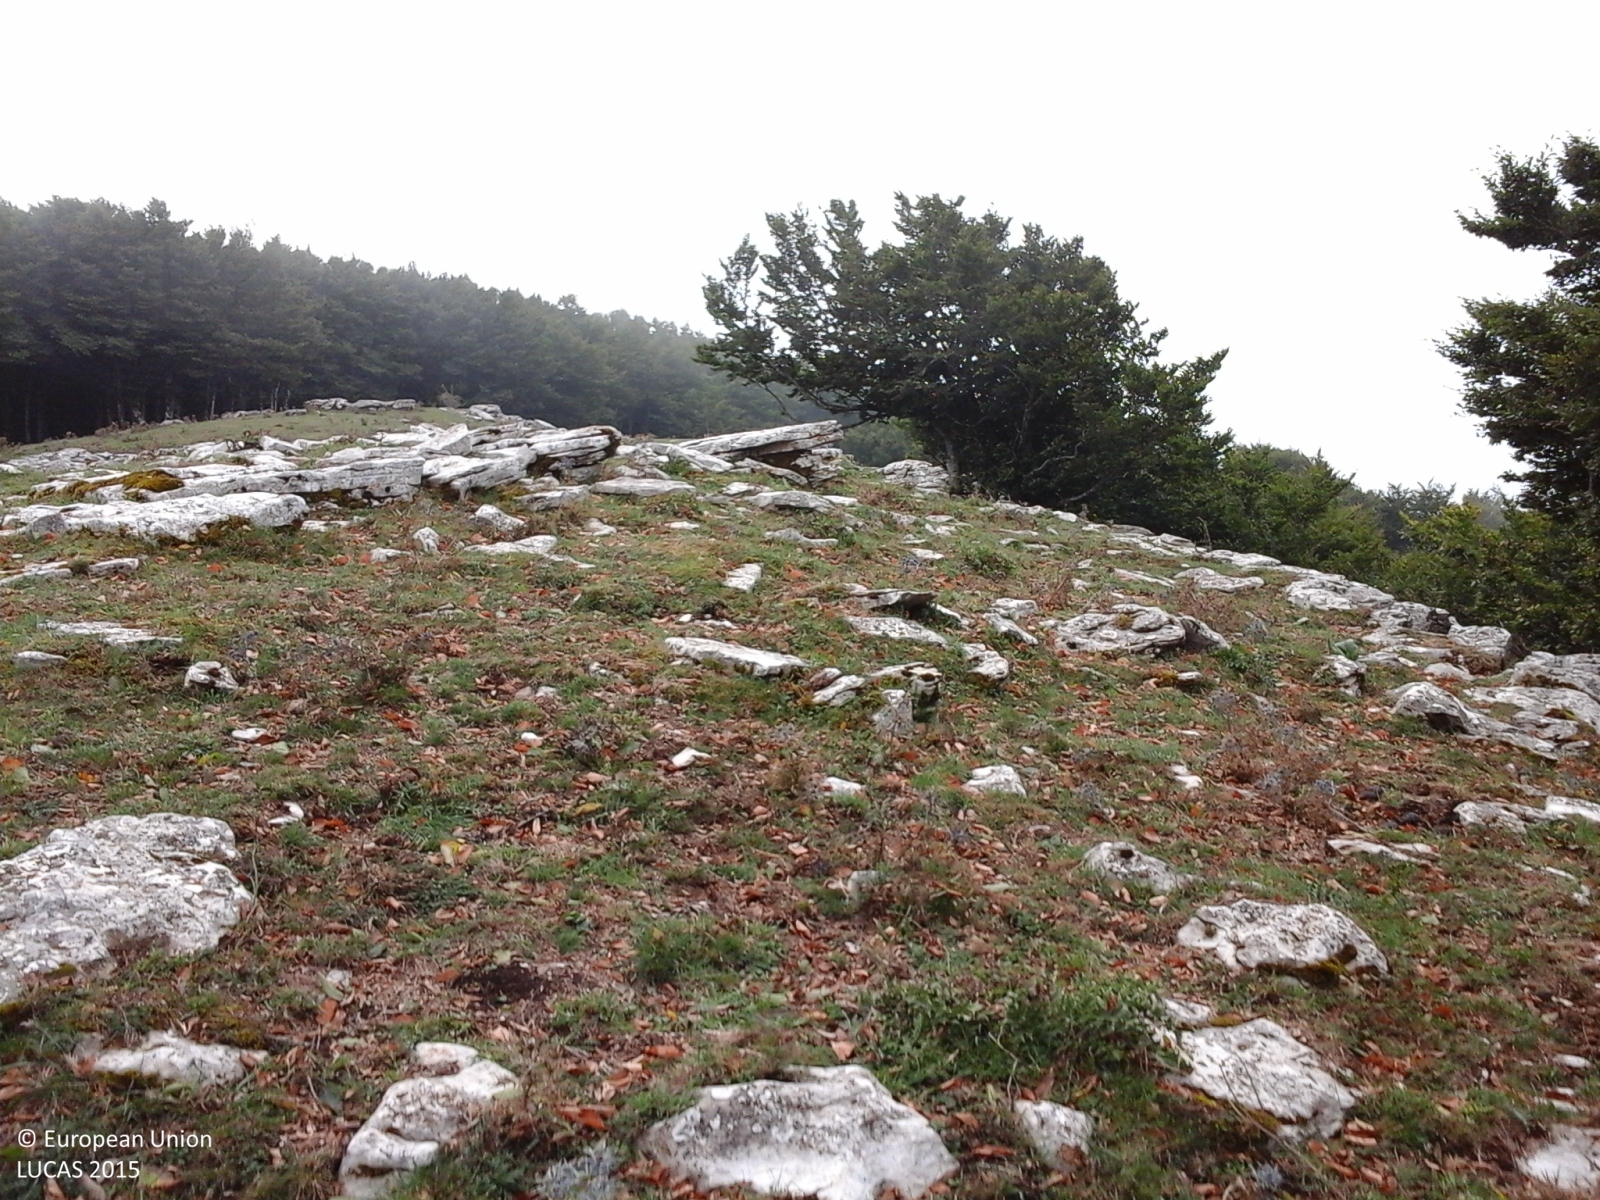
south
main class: Woodland
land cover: Broadleaved woodland
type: mountainous beech forest
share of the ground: > 75 %
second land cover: Grassland without tree/shrub cover
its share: > 75 %
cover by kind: broadleaved forest trees 70 %, shrubs 20 %, herbaceous plants 10 %
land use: Forestry
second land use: Agriculture (excluding fallow land and kitchen gardens)
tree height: > 5 m
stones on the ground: 25 - 50 %
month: September
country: IT
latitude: 41.6362
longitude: 14.3903
